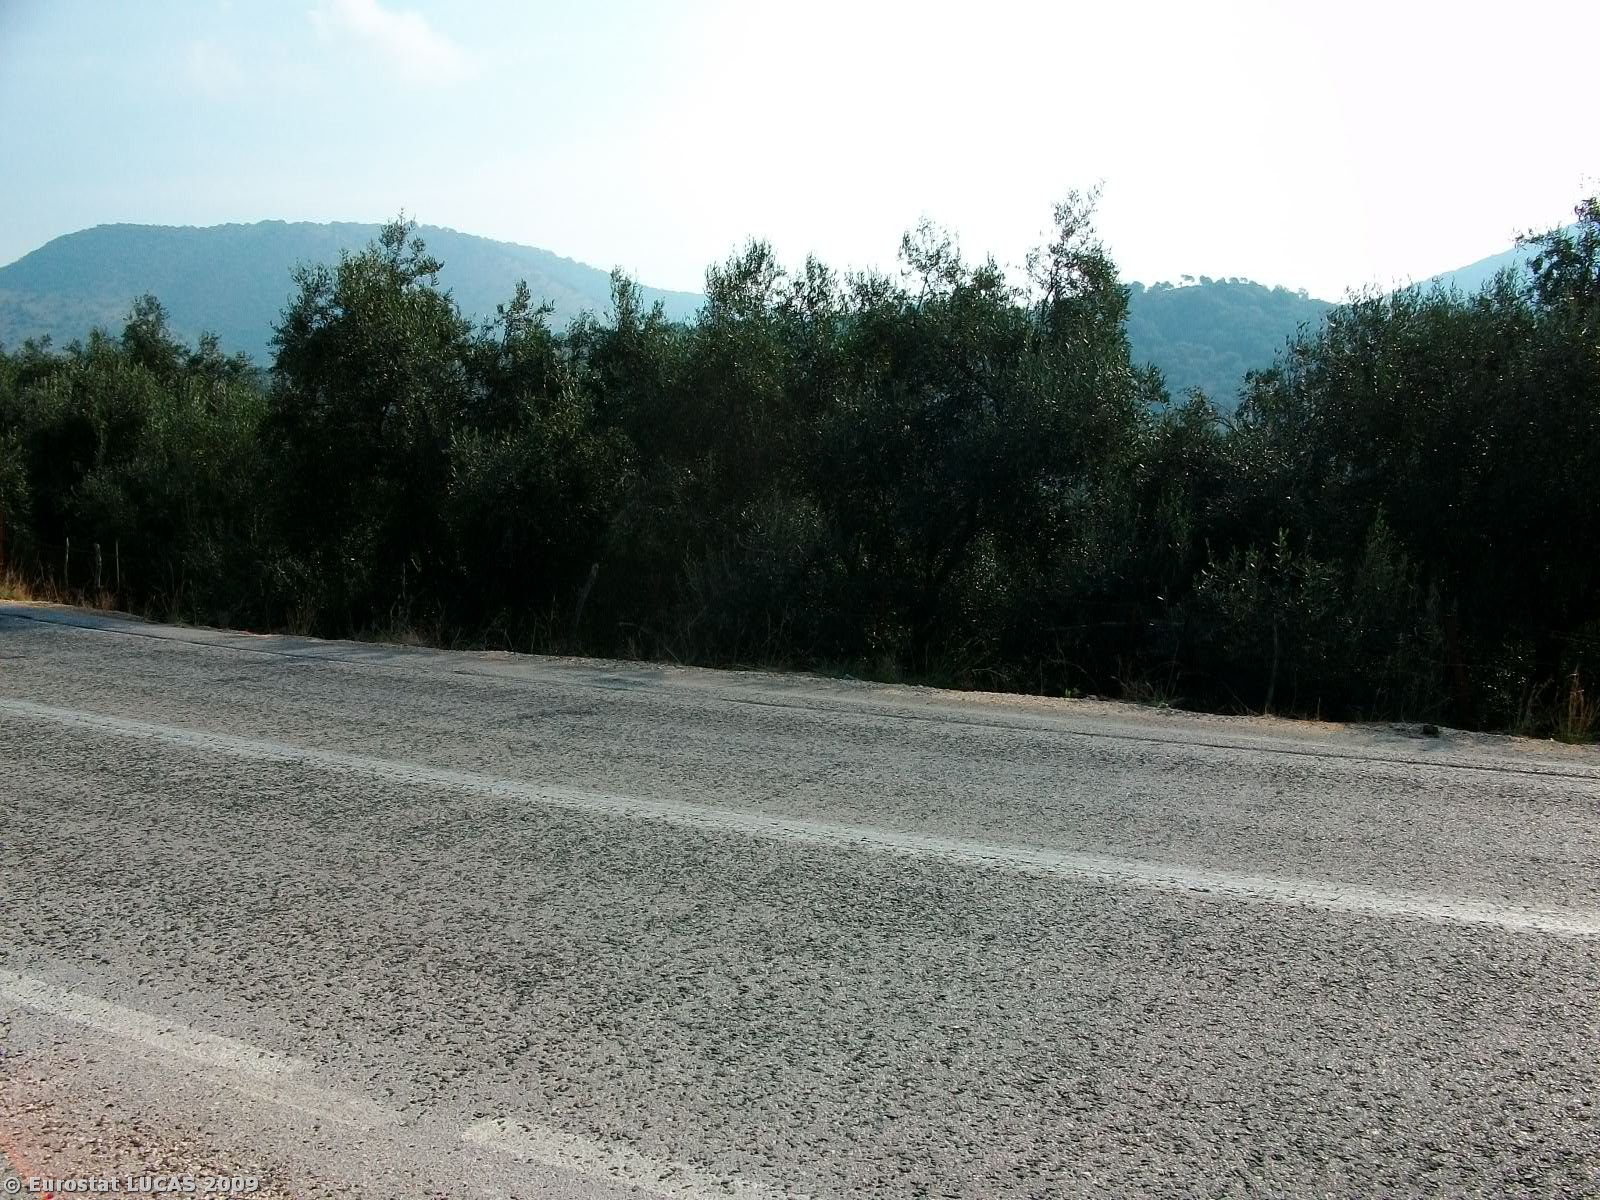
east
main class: Shrubland
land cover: Shrubland without tree cover
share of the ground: > 75 %
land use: Agriculture (excluding fallow land and kitchen gardens)
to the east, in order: Shrubland without tree cover; Fences; Olive groves; Grassland with sparse tree/shrub cover; Fences; Electric lines; Grass margins; Paved roads, cycling and walking lanes; Grass margins
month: October
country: GR
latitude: 39.2867
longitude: 20.4647
